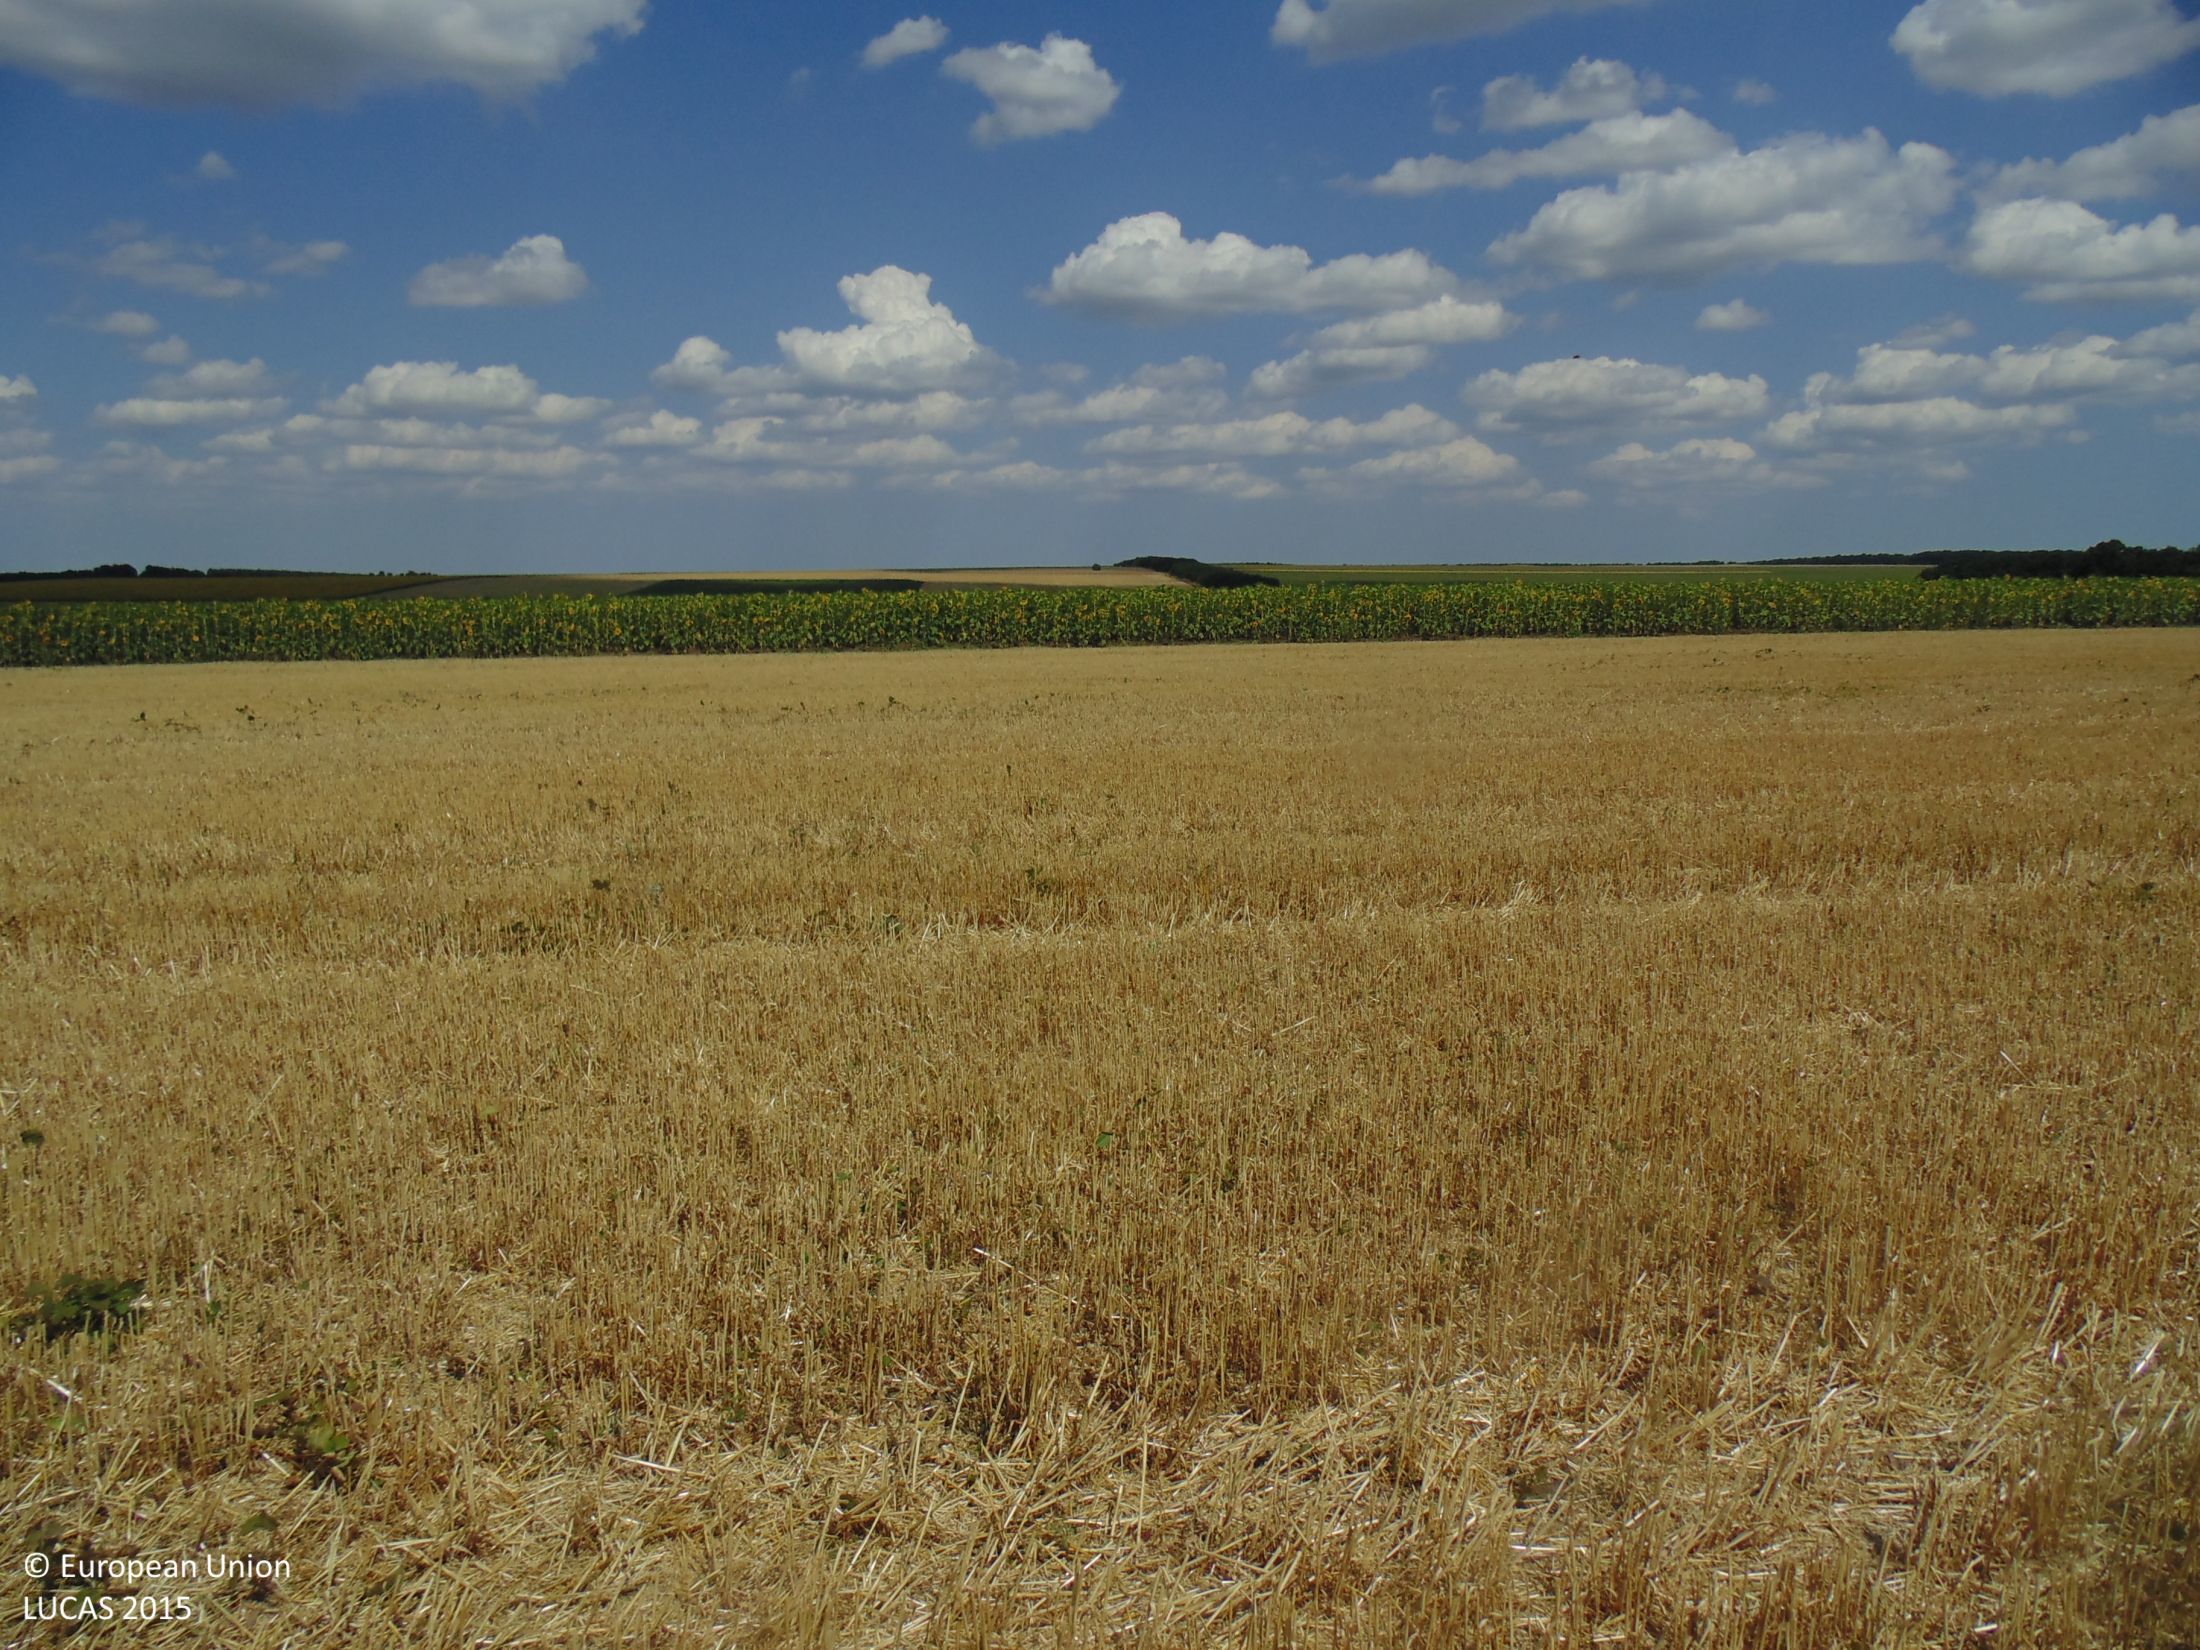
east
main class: Cropland
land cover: Common wheat
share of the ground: > 75 %
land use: Agriculture (excluding fallow land and kitchen gardens)
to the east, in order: Common wheat; Sunflower; Common wheat
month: July
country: BG
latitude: 43.5685
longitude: 27.7071
